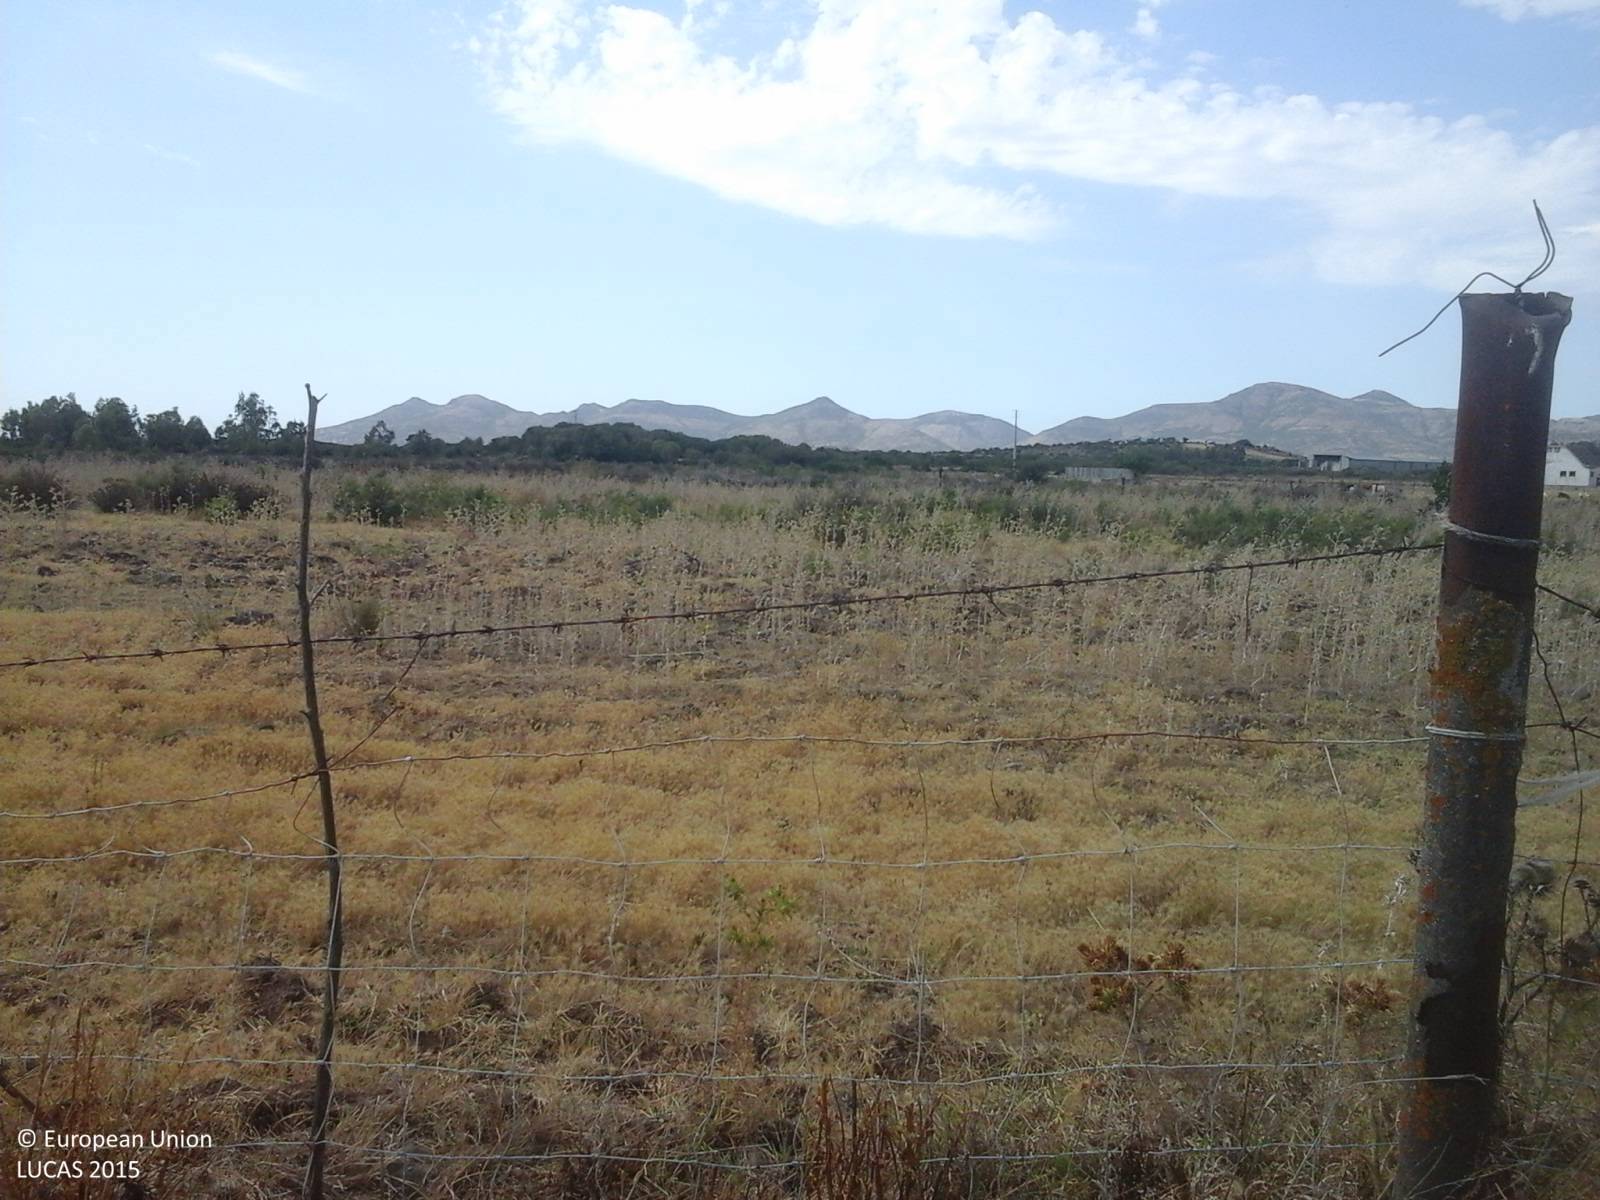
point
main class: Grassland
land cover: Grassland without tree/shrub cover
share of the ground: > 75 %
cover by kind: herbaceous plants 85 %, unconsolidated bare surface 15 %
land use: Agriculture (excluding fallow land and kitchen gardens)
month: July
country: IT
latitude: 39.0796
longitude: 8.5871
